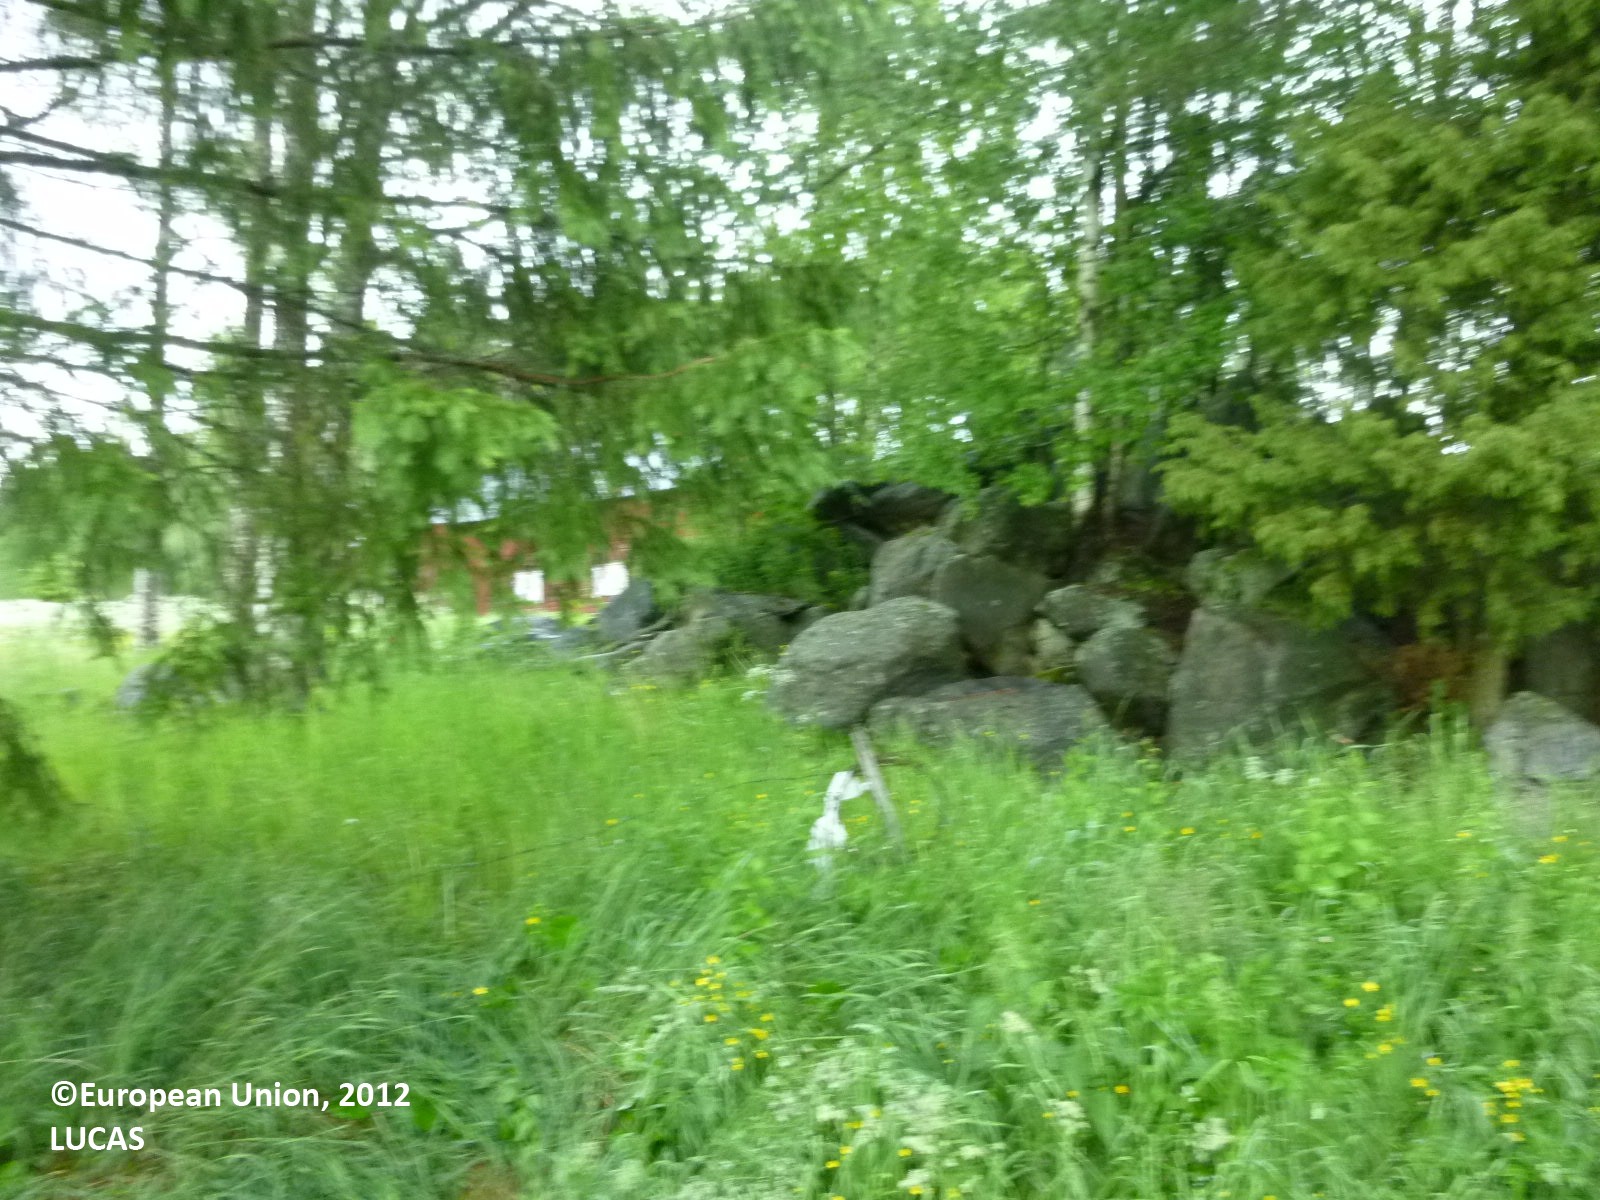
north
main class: Cropland
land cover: Oats
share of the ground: > 75 %
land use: Agriculture (excluding fallow land and kitchen gardens)
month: June
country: FI
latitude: 61.5387
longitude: 22.3058
